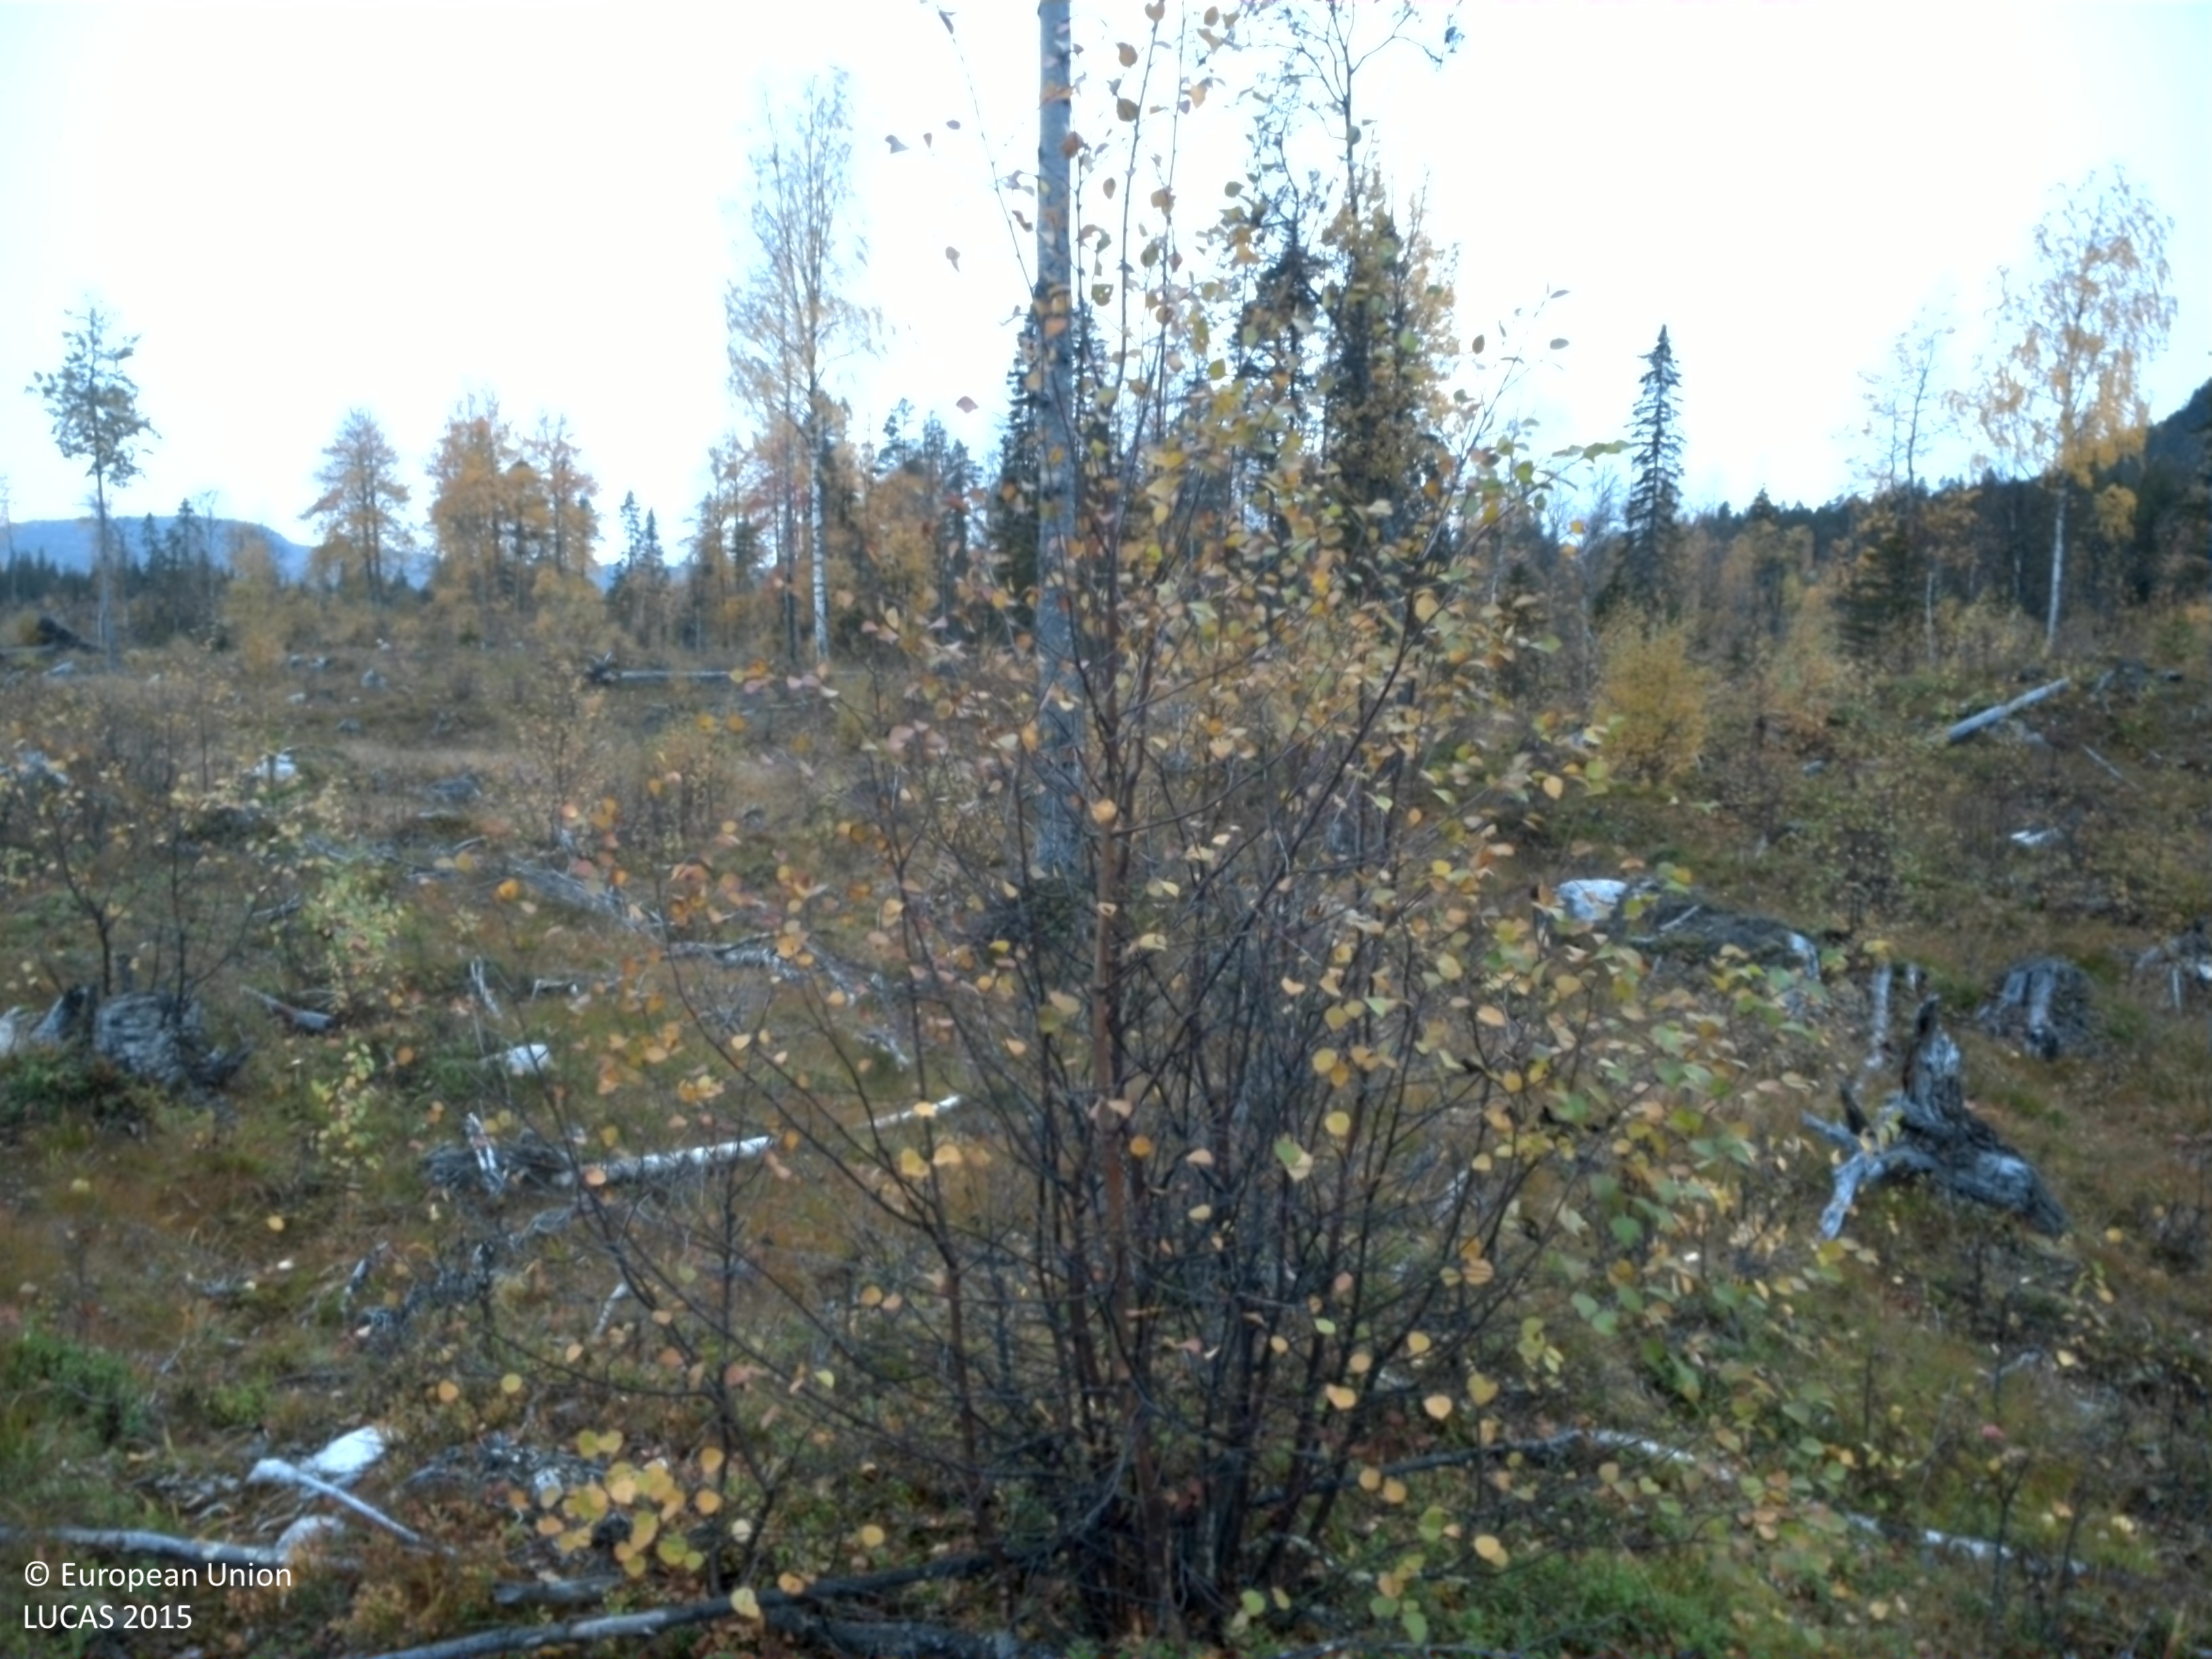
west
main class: Woodland
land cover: Broadleaved woodland
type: non-riverine alder, birch or aspen forest
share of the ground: 10 - 25 %
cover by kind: herbaceous plants 65 %, lichens and mosses 15 %, broadleaved forest trees 10 %, shrubs 5 %, unconsolidated bare surface 5 %
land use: Forestry
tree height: < 5 m
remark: Clear cut
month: October
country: SE
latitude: 64.9480
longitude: 17.4777
